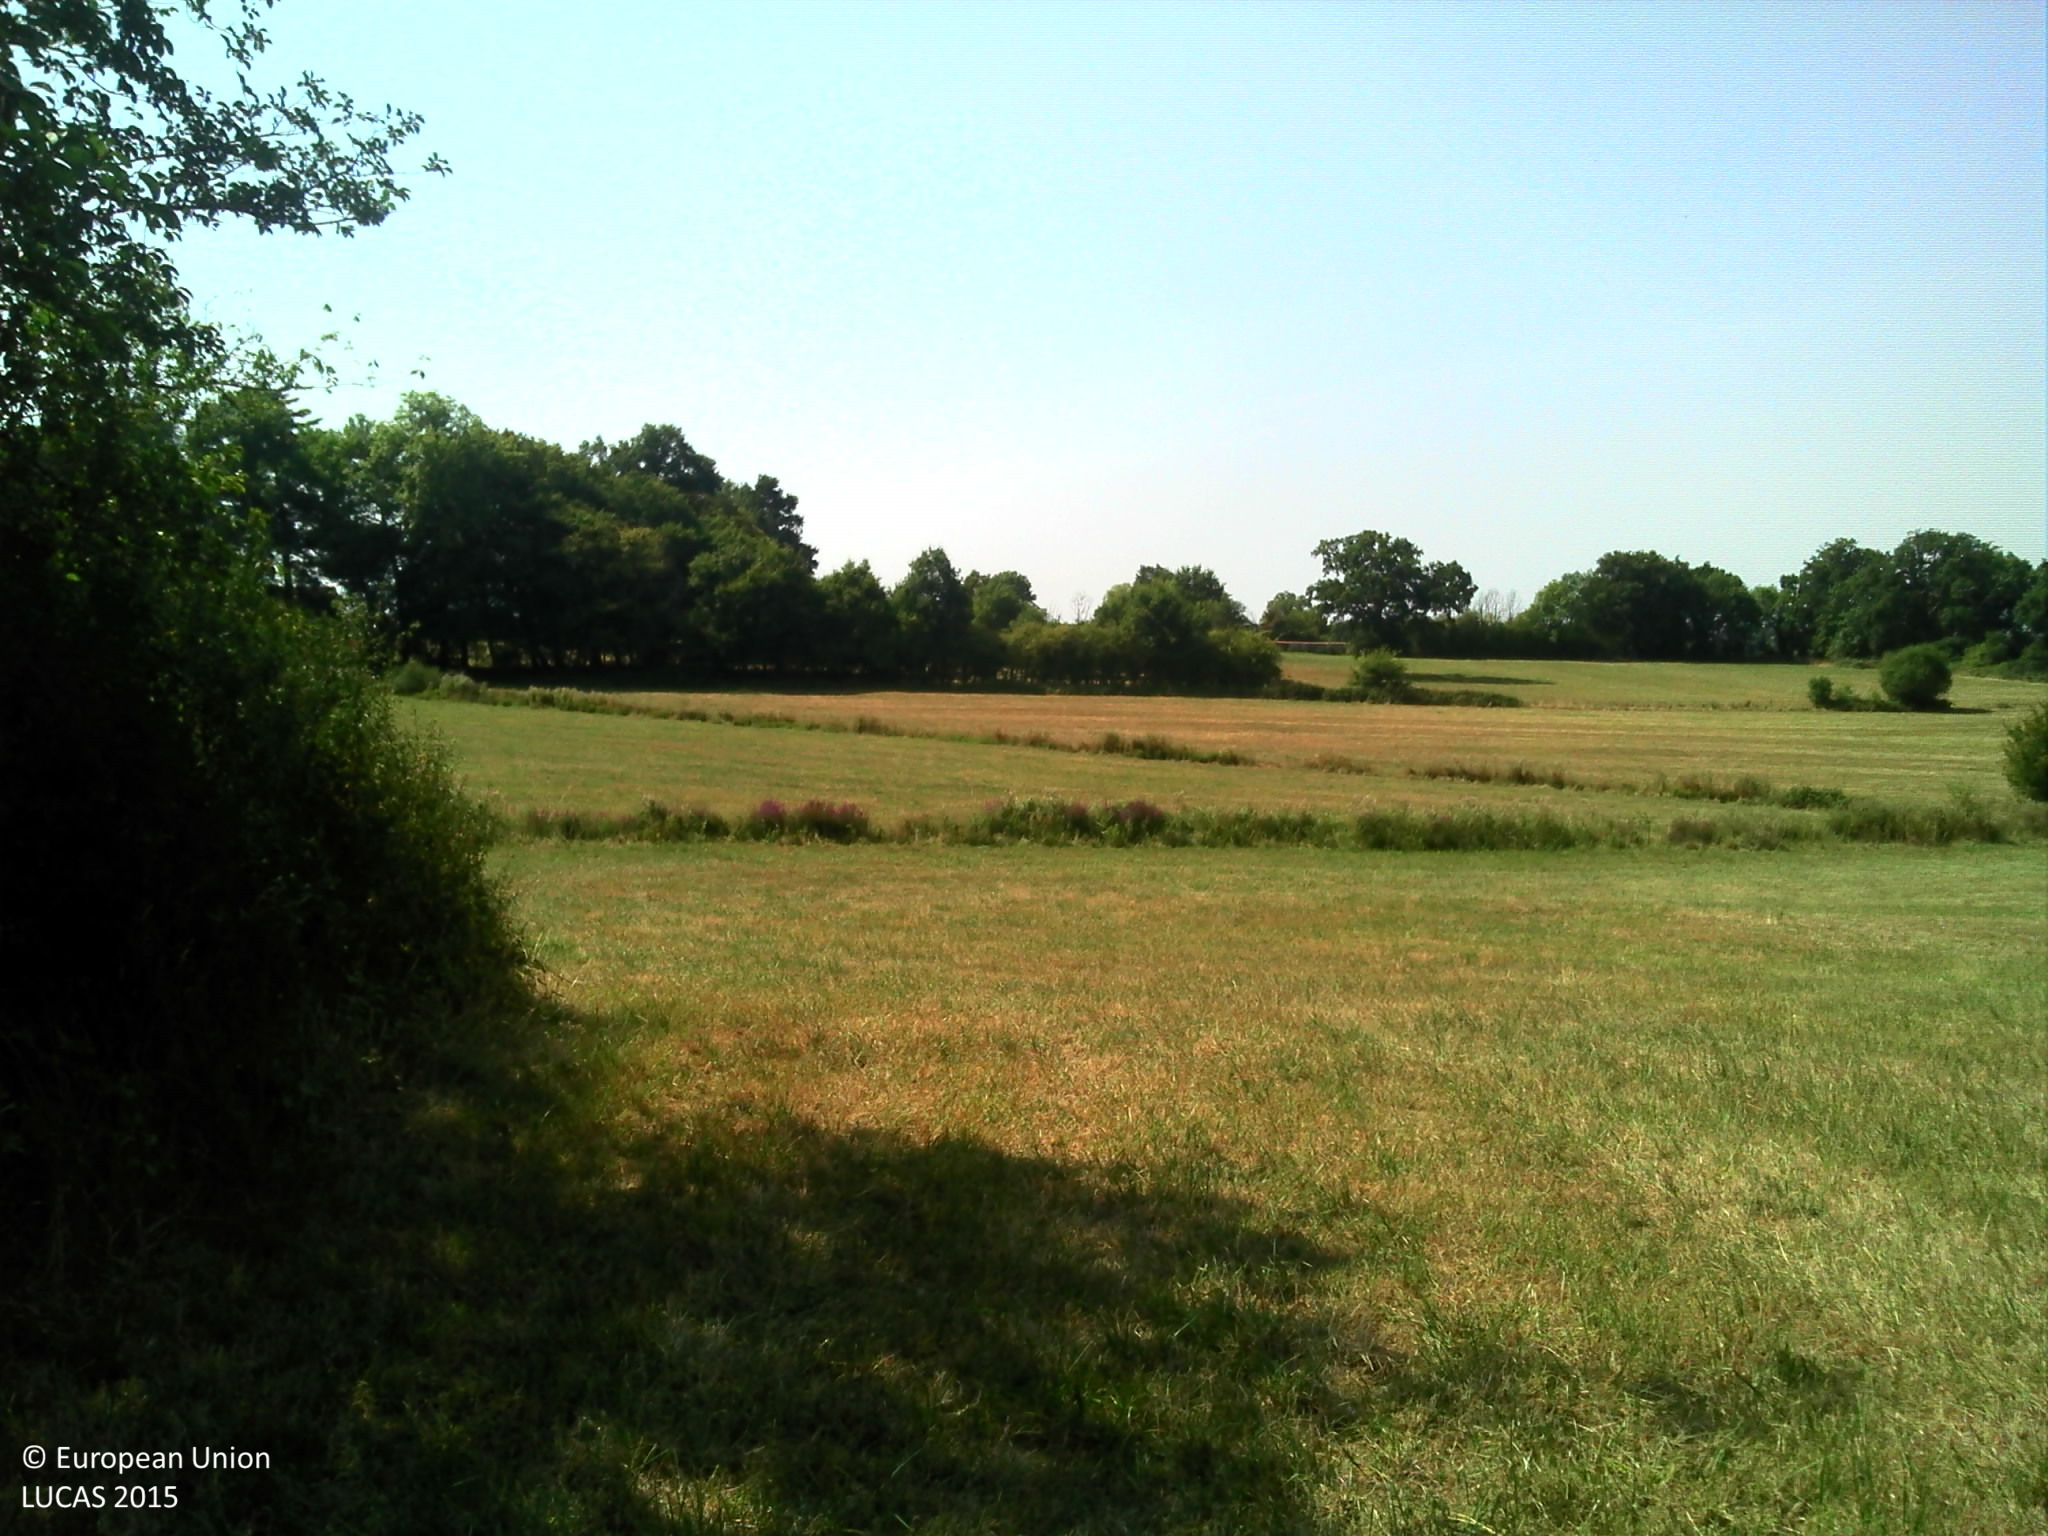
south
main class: Grassland
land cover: Grassland without tree/shrub cover
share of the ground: > 75 %
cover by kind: herbaceous plants 100 %
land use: Agriculture (excluding fallow land and kitchen gardens)
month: August
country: FR
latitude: 46.7187
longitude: 2.7345
